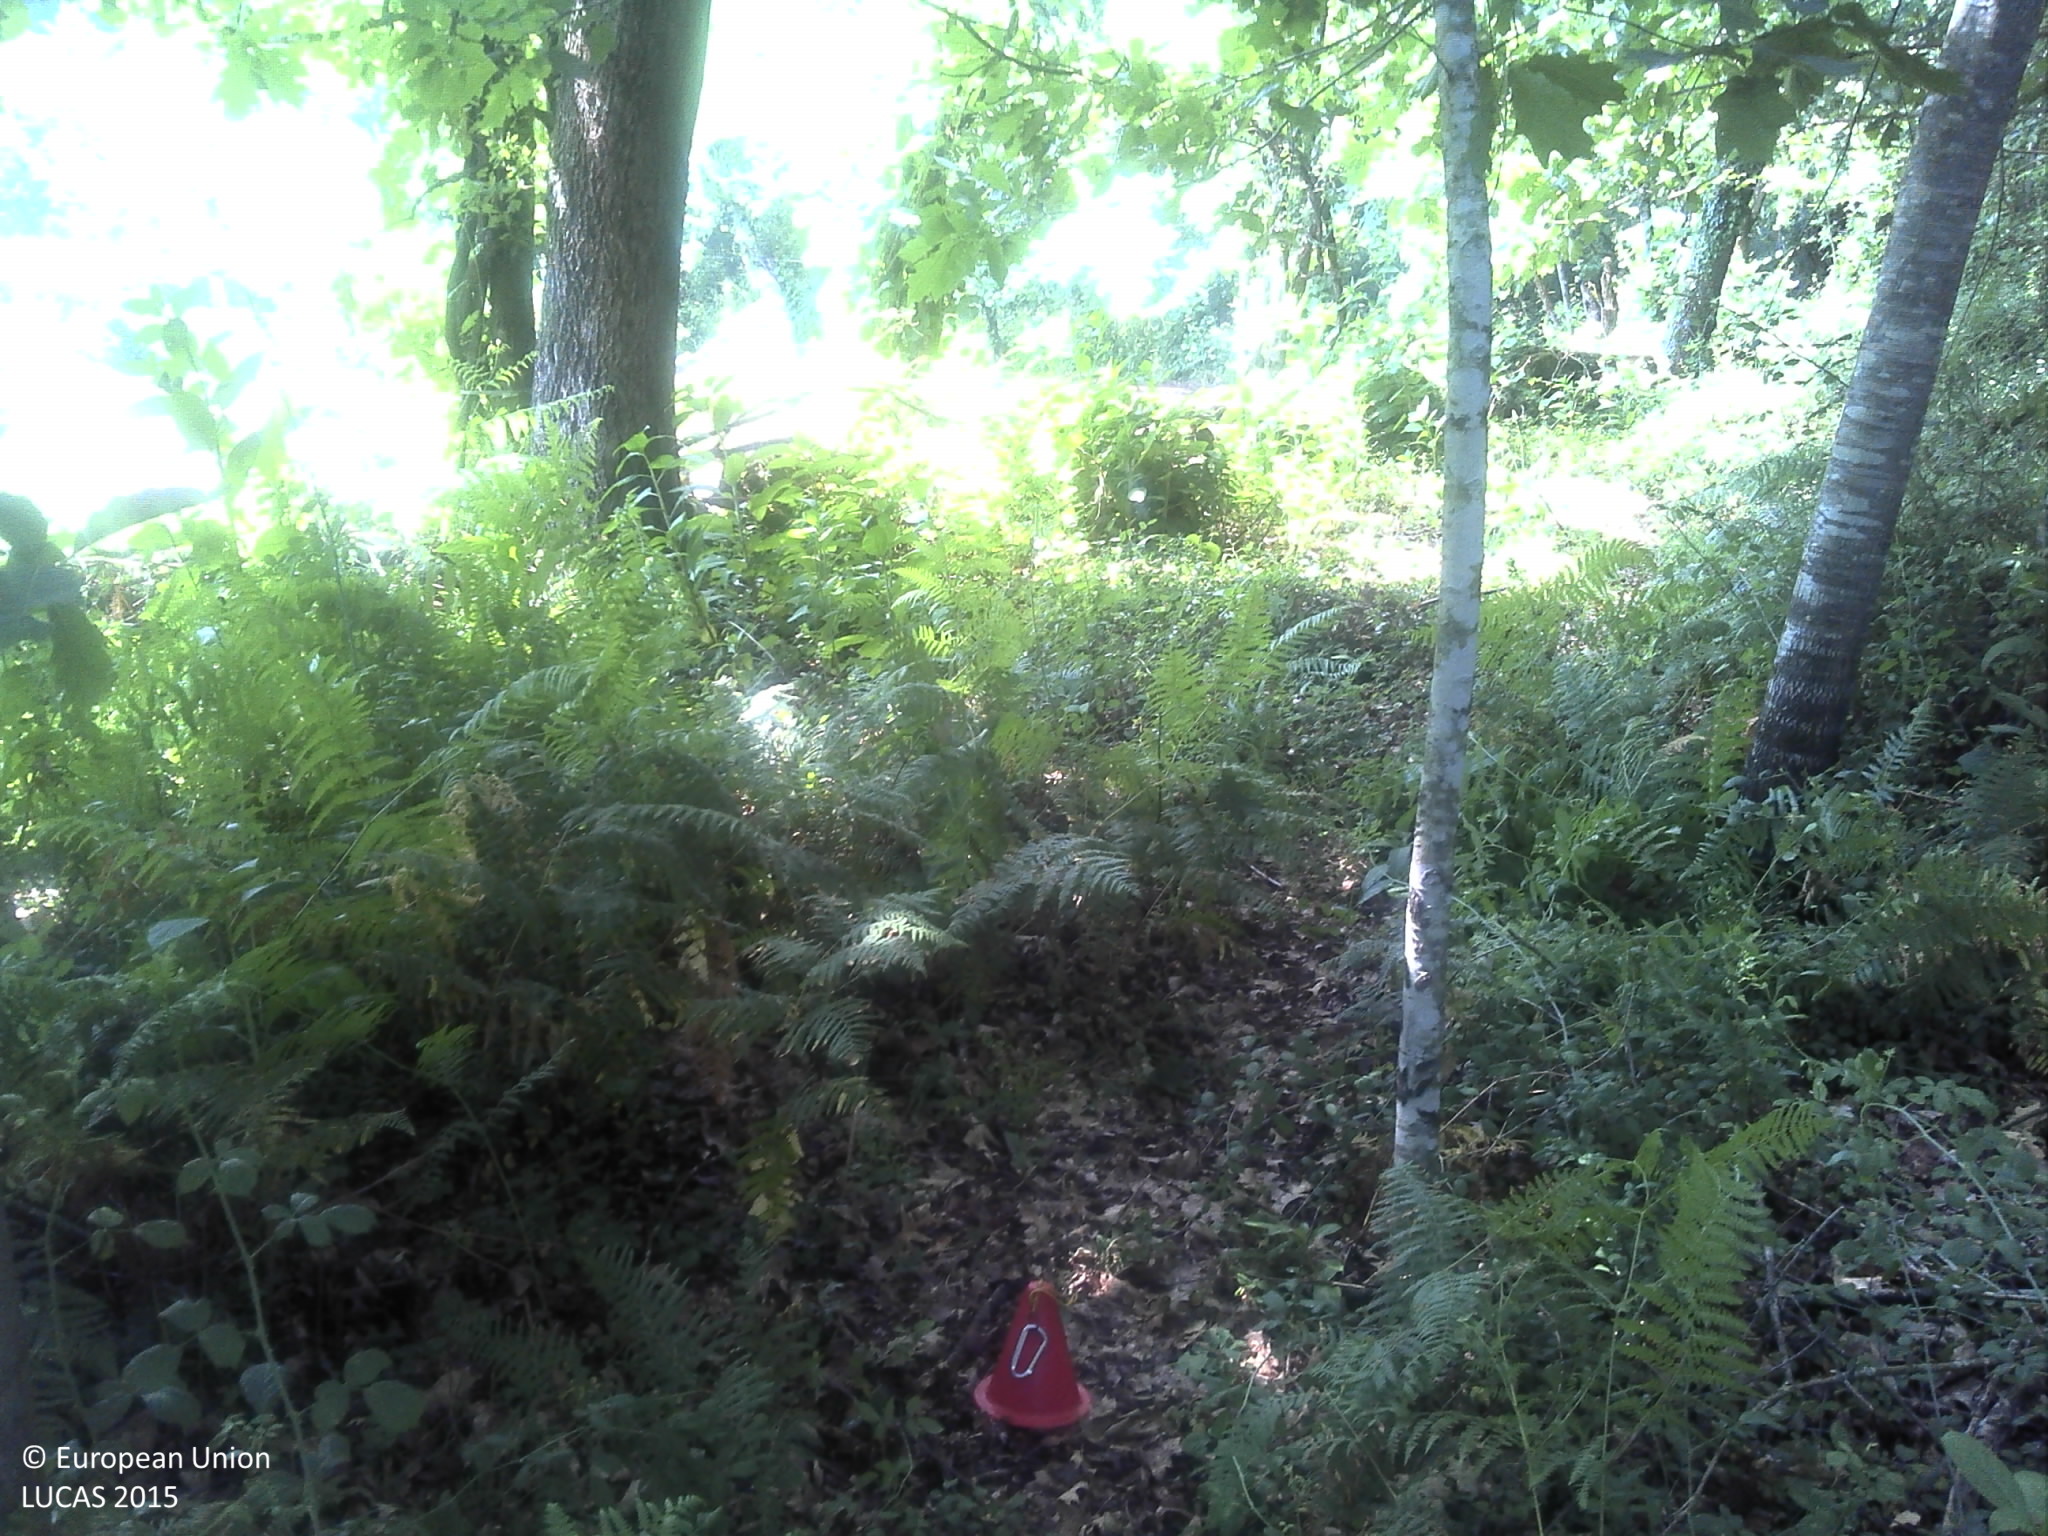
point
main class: Woodland
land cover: Broadleaved woodland
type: acidophilous oak and oak-birch forest
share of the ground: > 75 %
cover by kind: broadleaved forest trees 70 %, shrubs 20 %, herbaceous plants 10 %
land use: Forestry
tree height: > 5 m
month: June
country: PT
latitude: 41.6978
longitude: -8.3587
